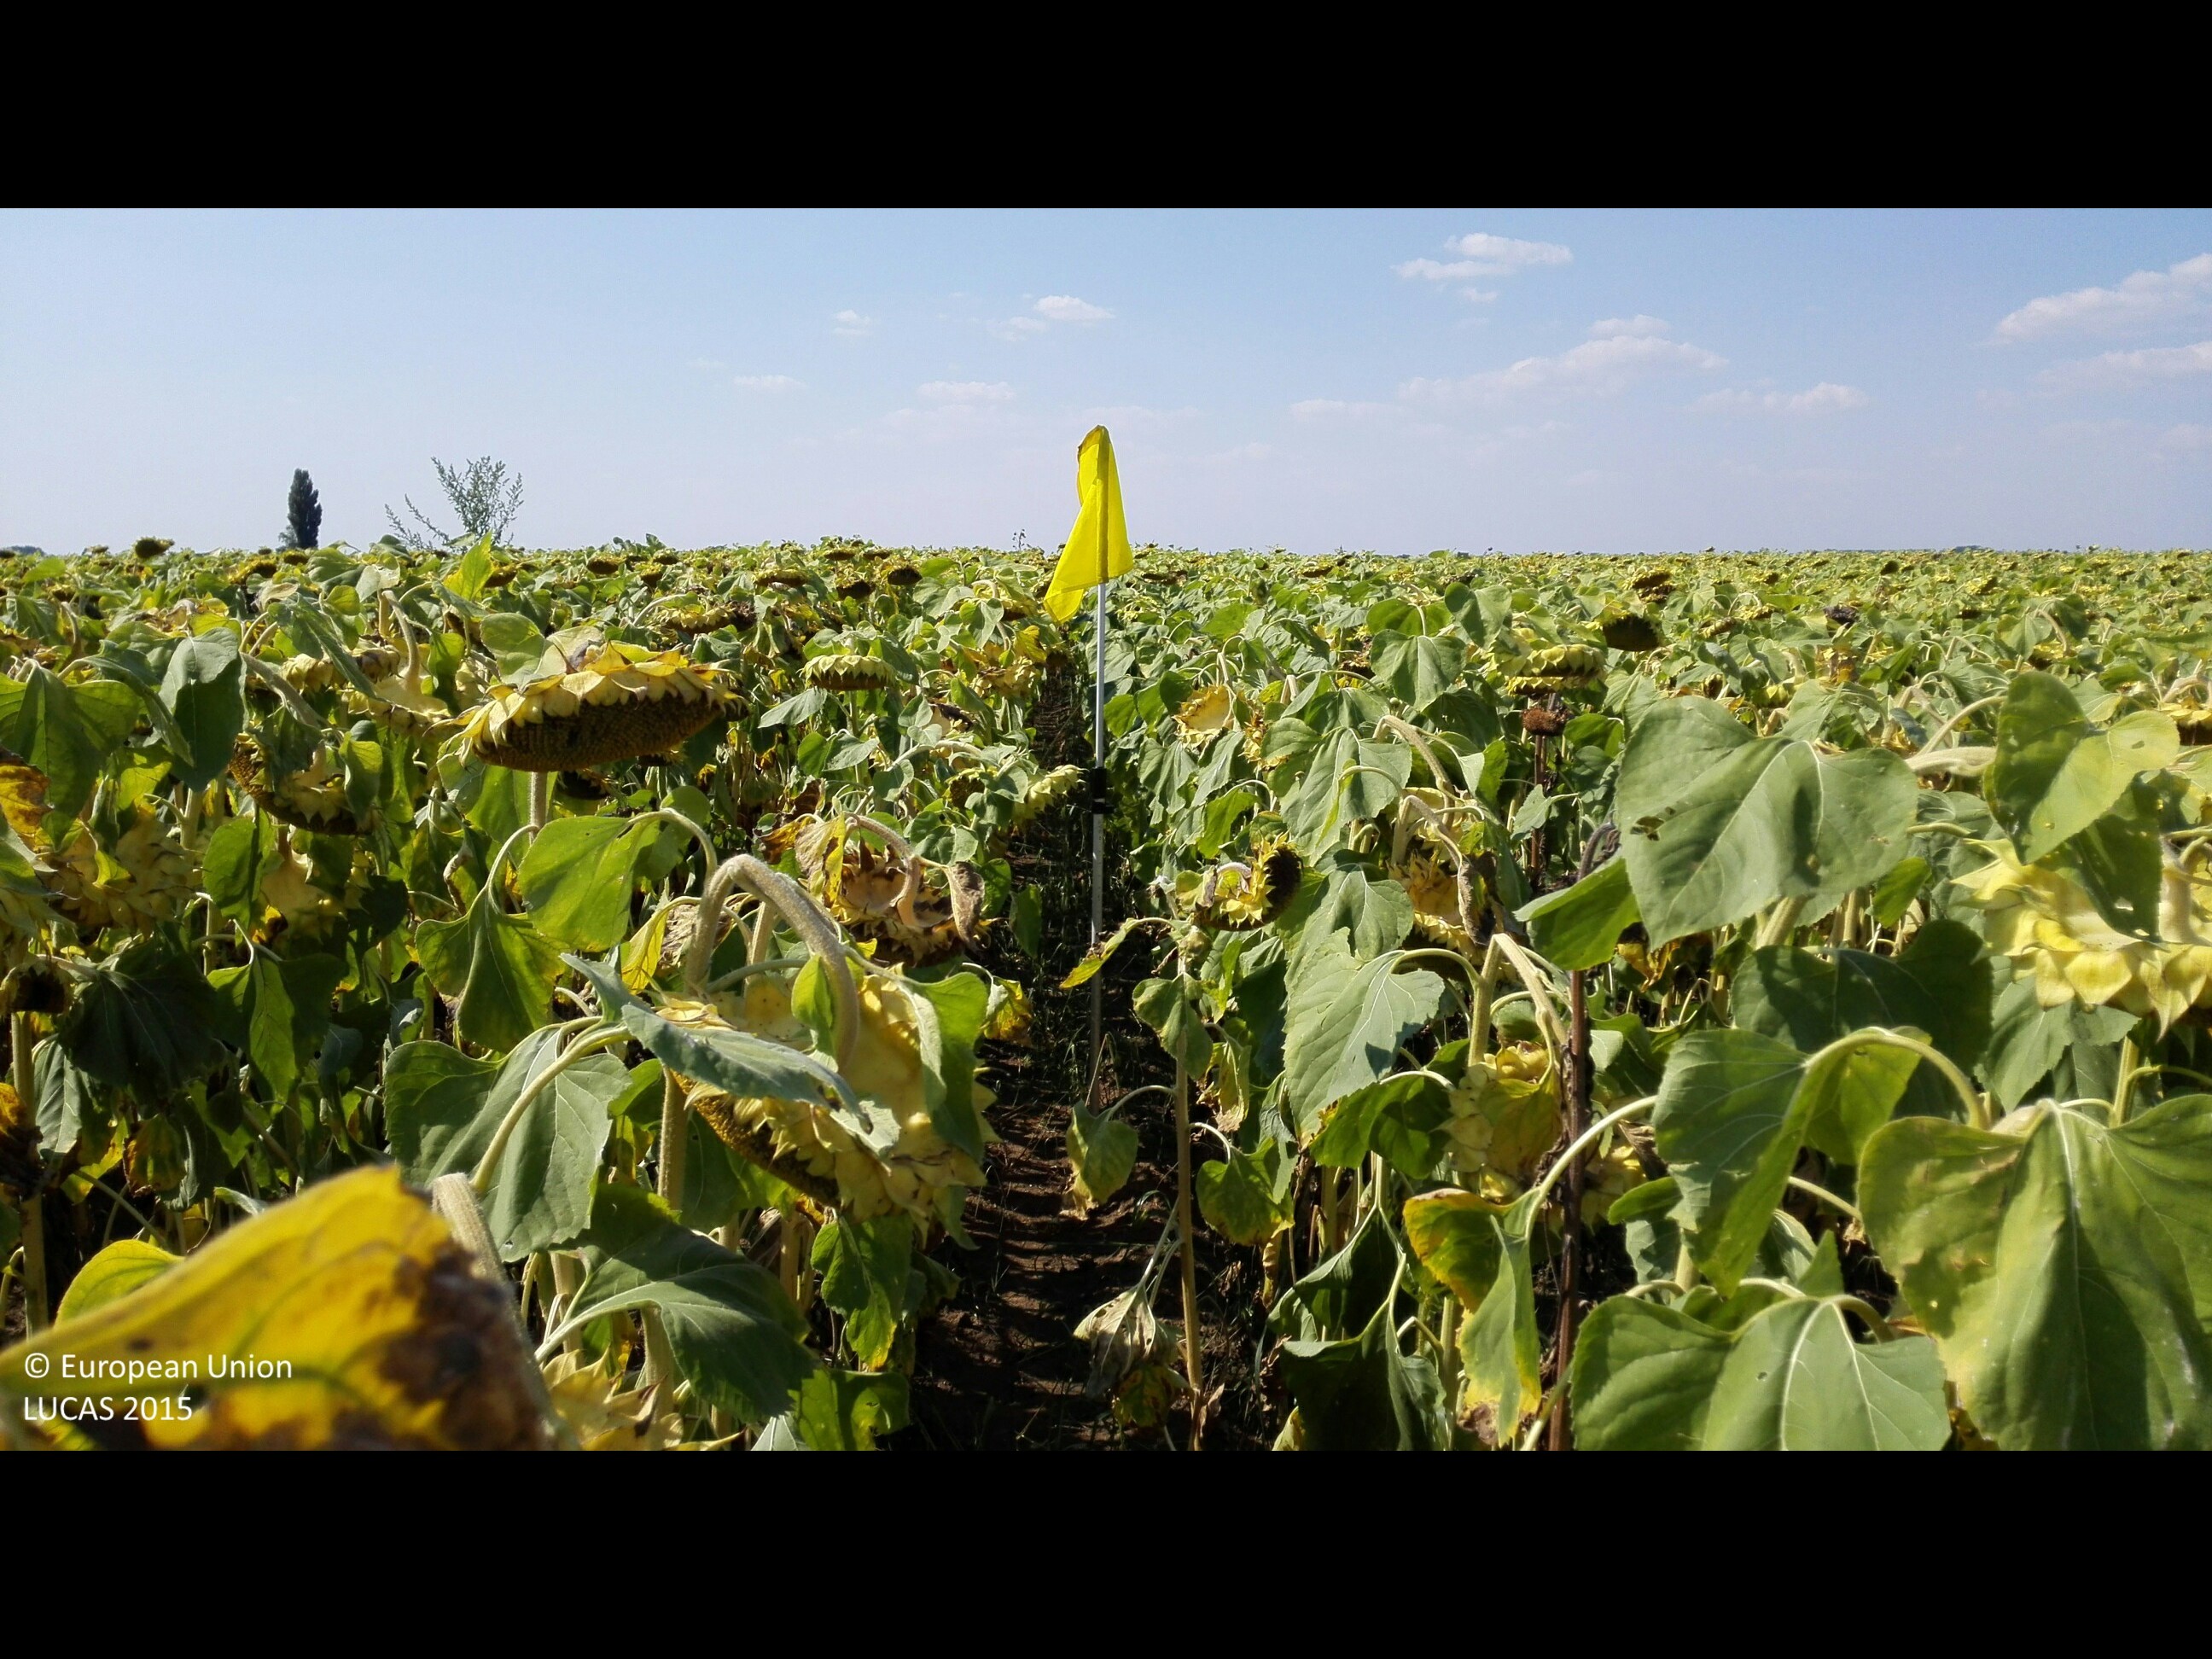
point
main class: Cropland
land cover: Sunflower
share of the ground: > 75 %
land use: Agriculture (excluding fallow land and kitchen gardens)
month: August
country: HU
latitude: 47.3555
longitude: 21.9232
